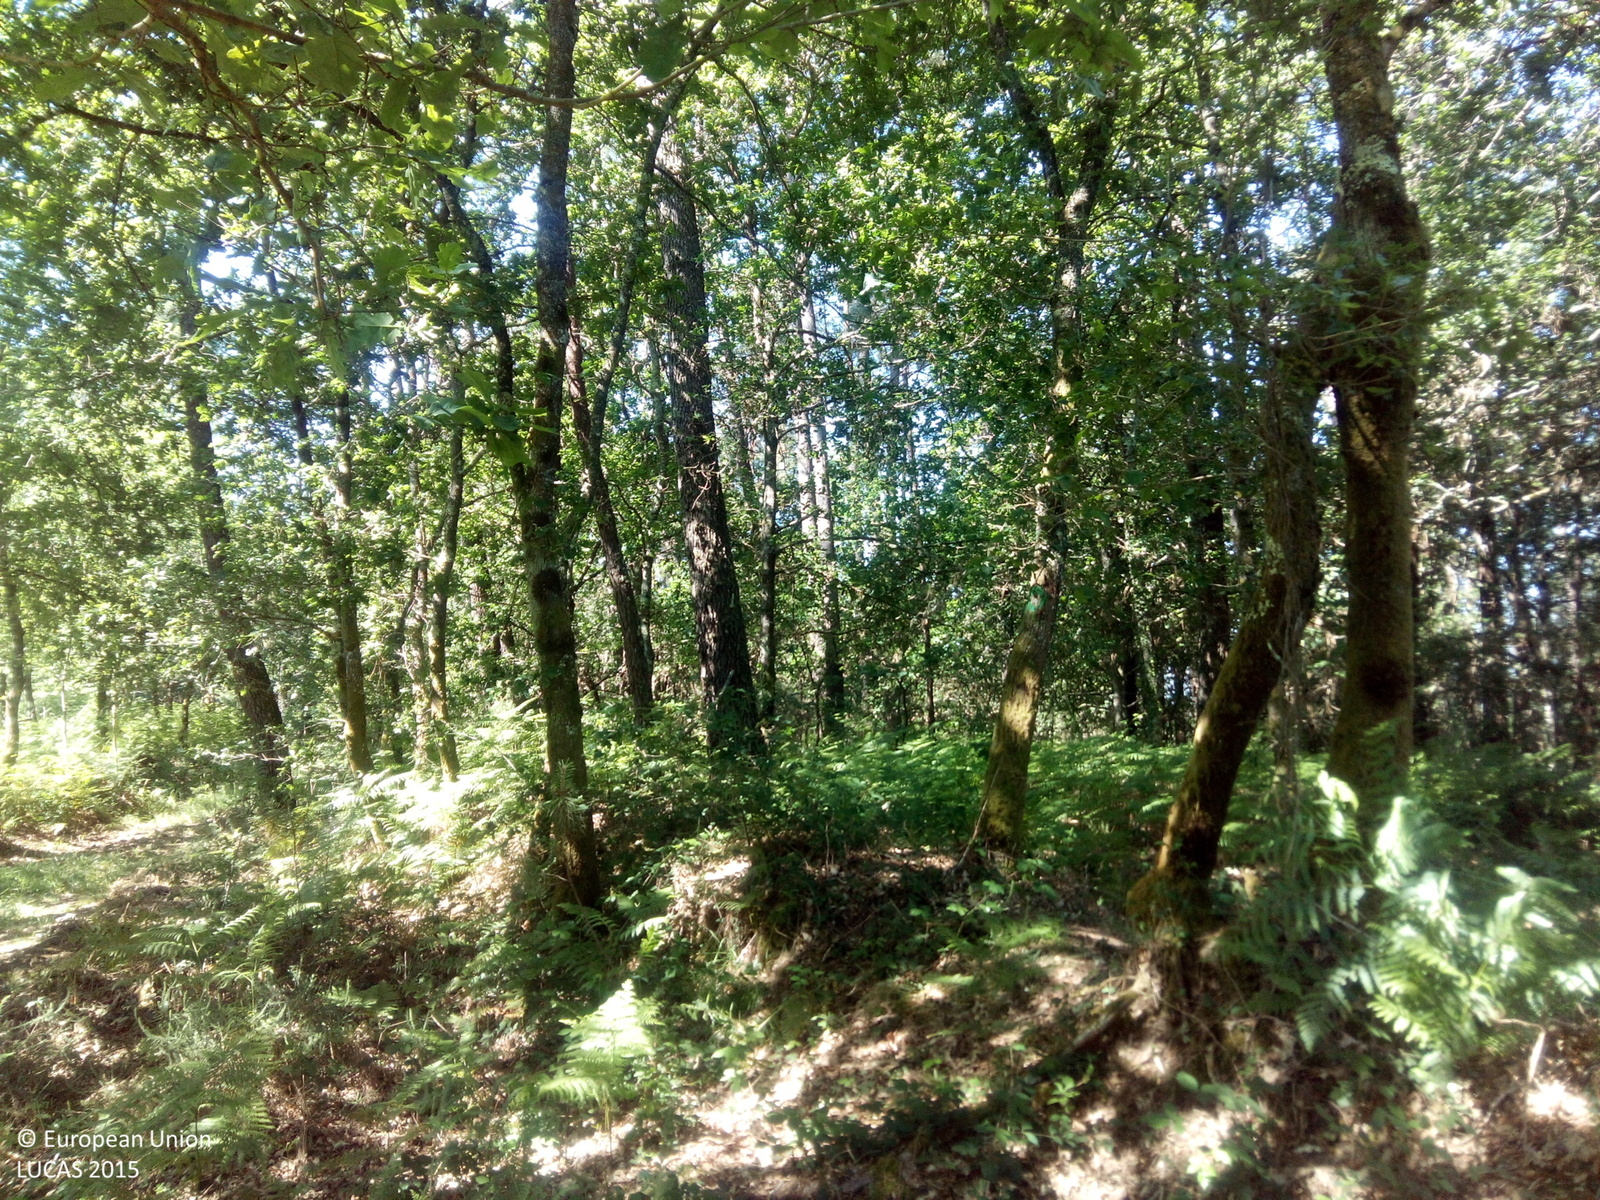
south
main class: Woodland
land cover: Broadleaved woodland
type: acidophilous oak and oak-birch forest
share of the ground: > 75 %
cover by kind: broadleaved forest trees 80 %, shrubs 20 %
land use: Forestry
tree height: > 5 m
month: May
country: ES
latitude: 42.7758
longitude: -8.5218
